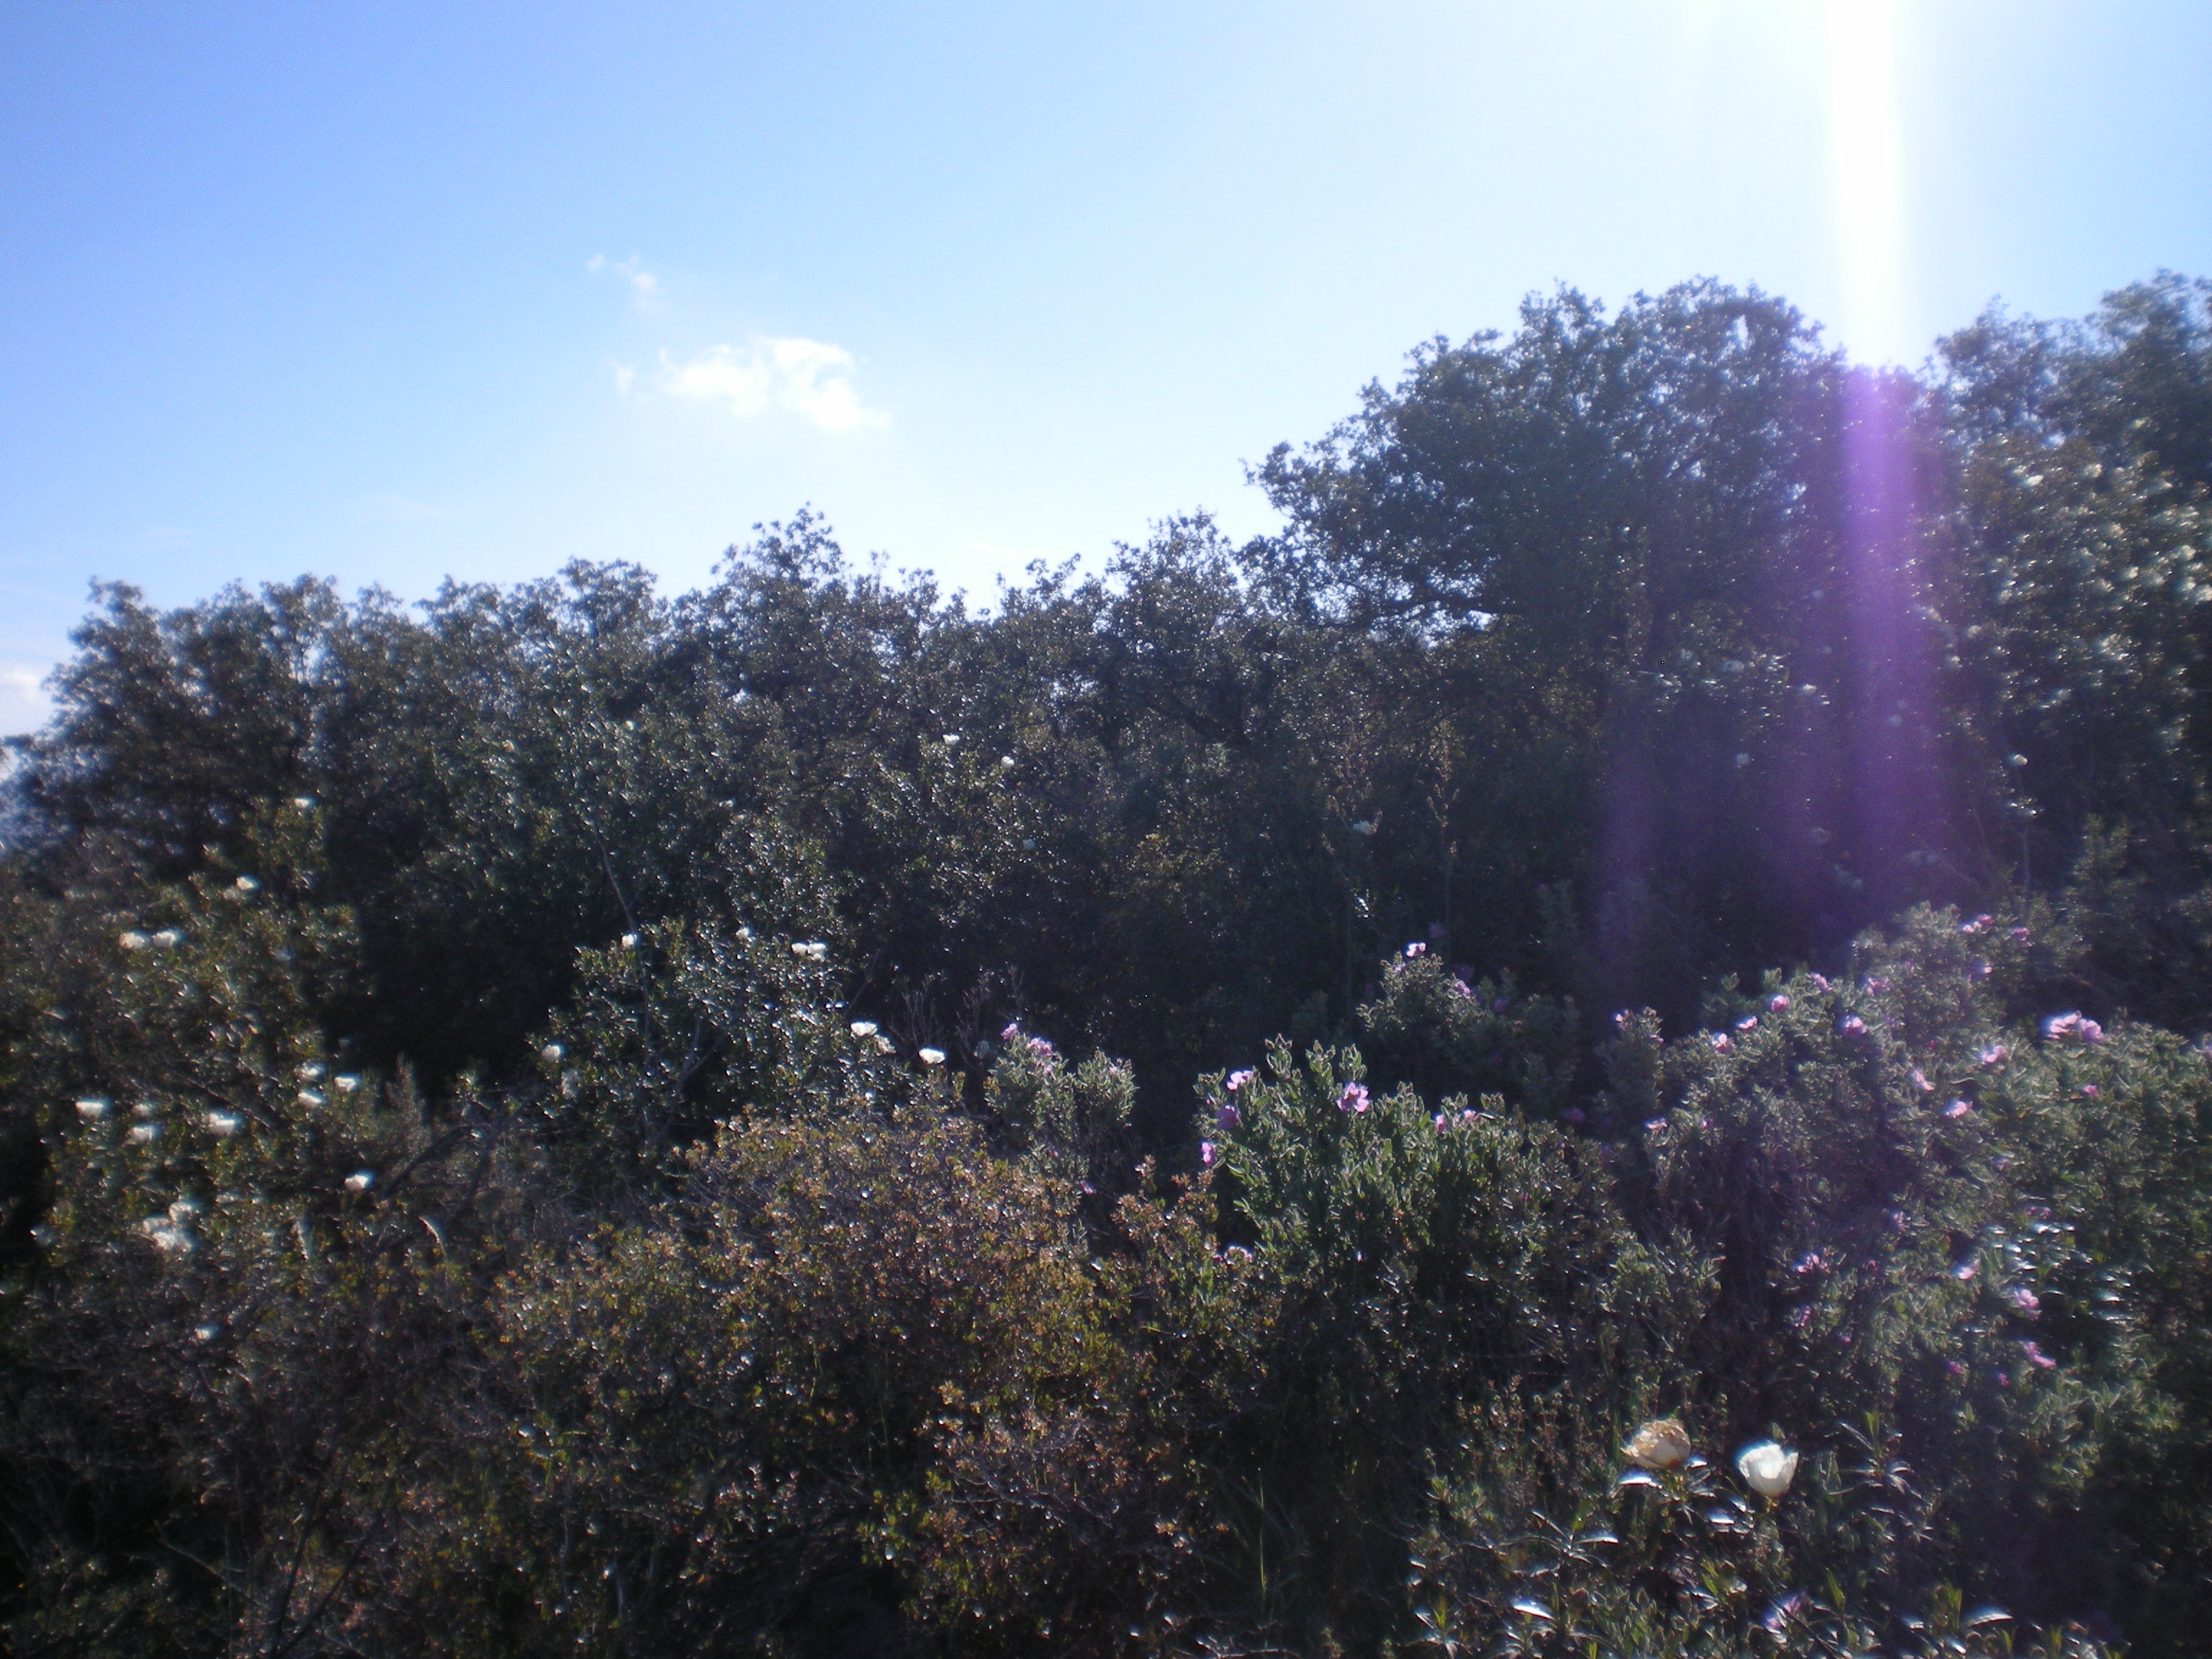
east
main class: Shrubland
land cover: Shrubland with sparse tree cover
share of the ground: > 75 %
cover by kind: shrubs 80 %, consolidated bare surface 15 %, broadleaved forest trees 5 %
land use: Other primary production
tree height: < 5 m
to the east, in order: Shrubland with sparse tree cover; Broadleaved woodland; Shrubland with sparse tree cover
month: April
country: ES
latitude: 38.5651
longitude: -3.3321
